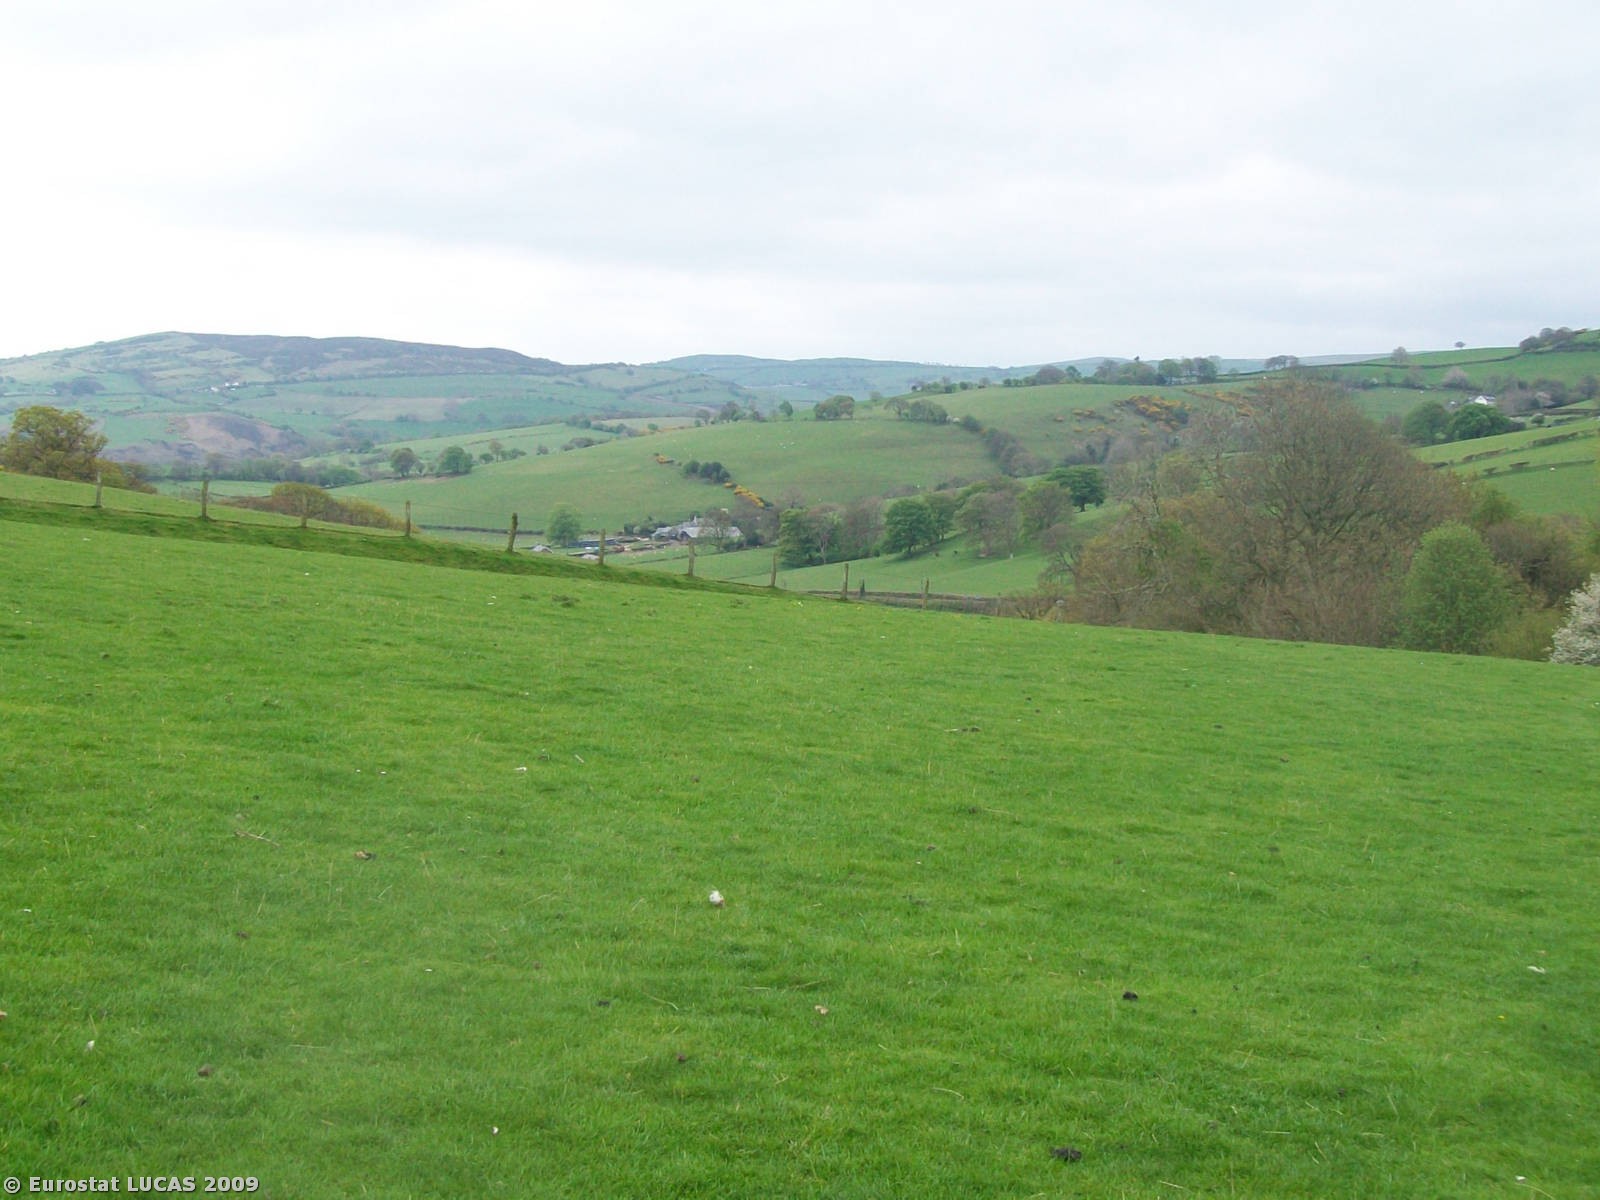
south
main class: Grassland
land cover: Grassland without tree/shrub cover
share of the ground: > 75 %
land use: Agriculture (excluding fallow land and kitchen gardens)
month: April
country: GB
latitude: 53.1701
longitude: -3.5027
